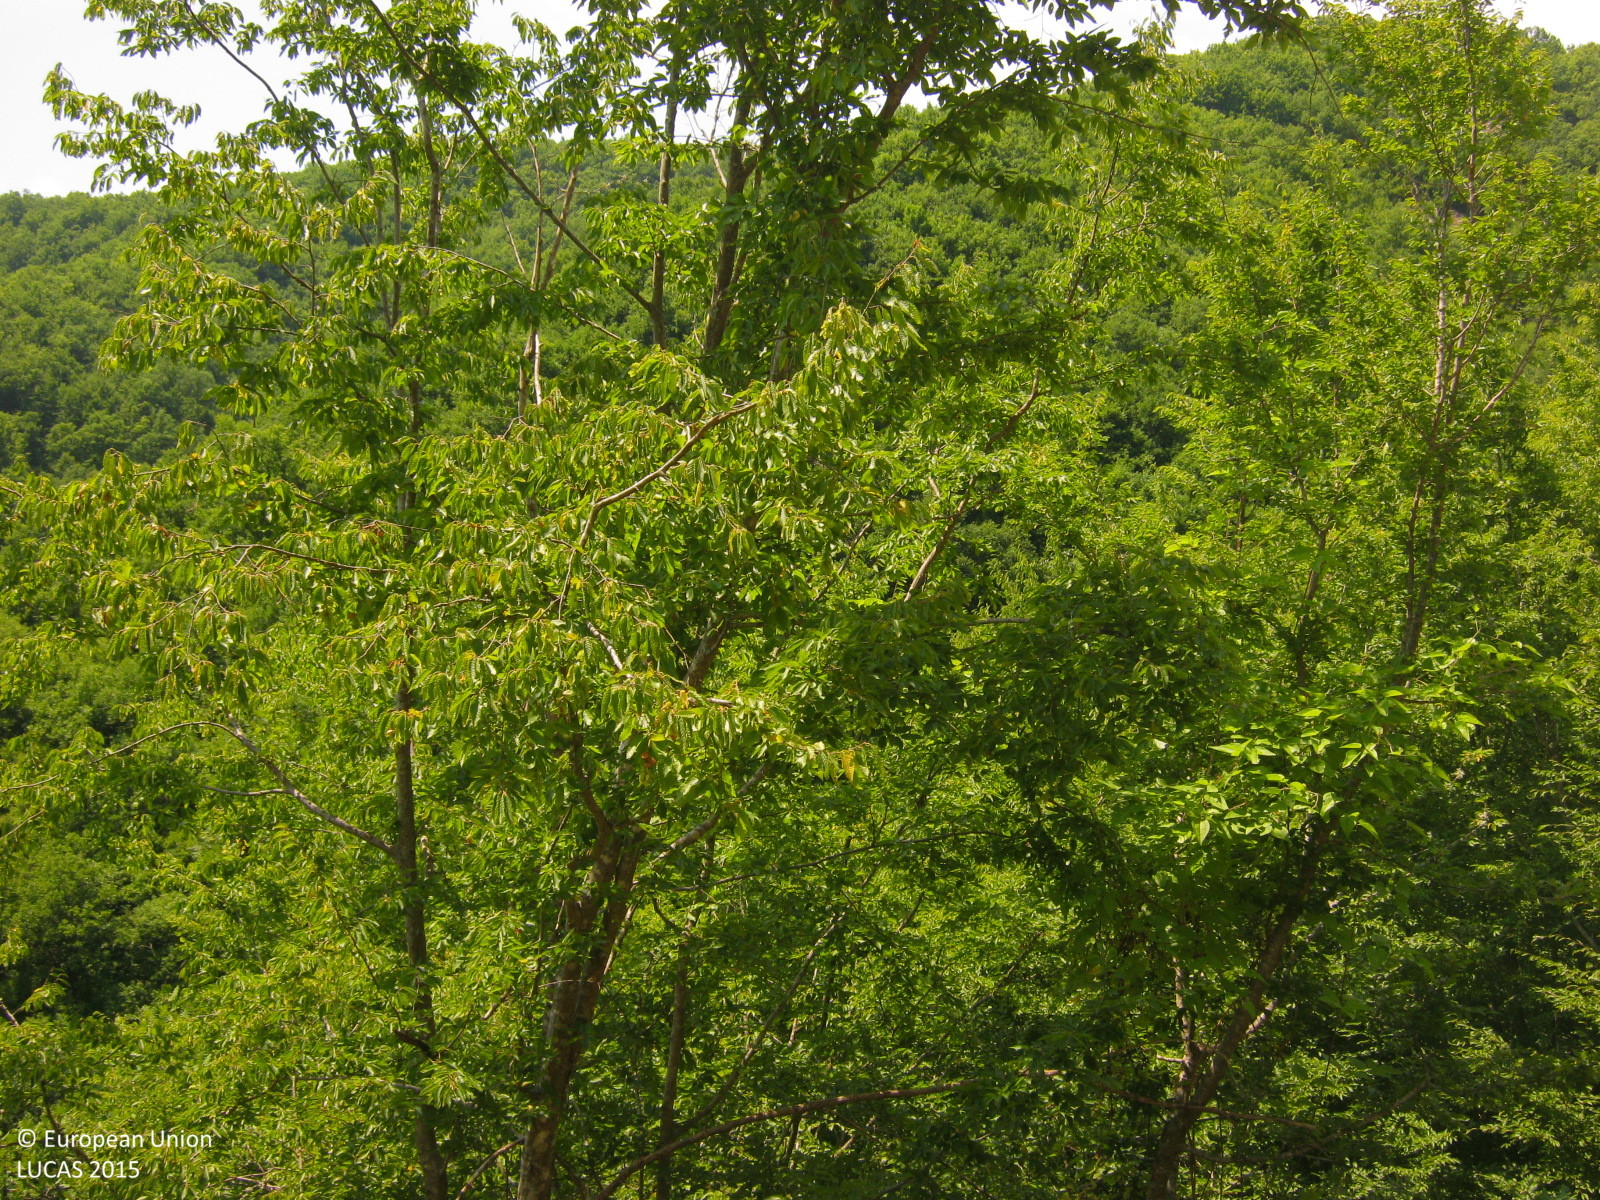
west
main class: Woodland
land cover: Broadleaved woodland
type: thermophilous deciduous forest
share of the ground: > 75 %
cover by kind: broadleaved forest trees 100 %
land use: Forestry
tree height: > 5 m
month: July
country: GR
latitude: 41.2688
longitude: 25.0267
